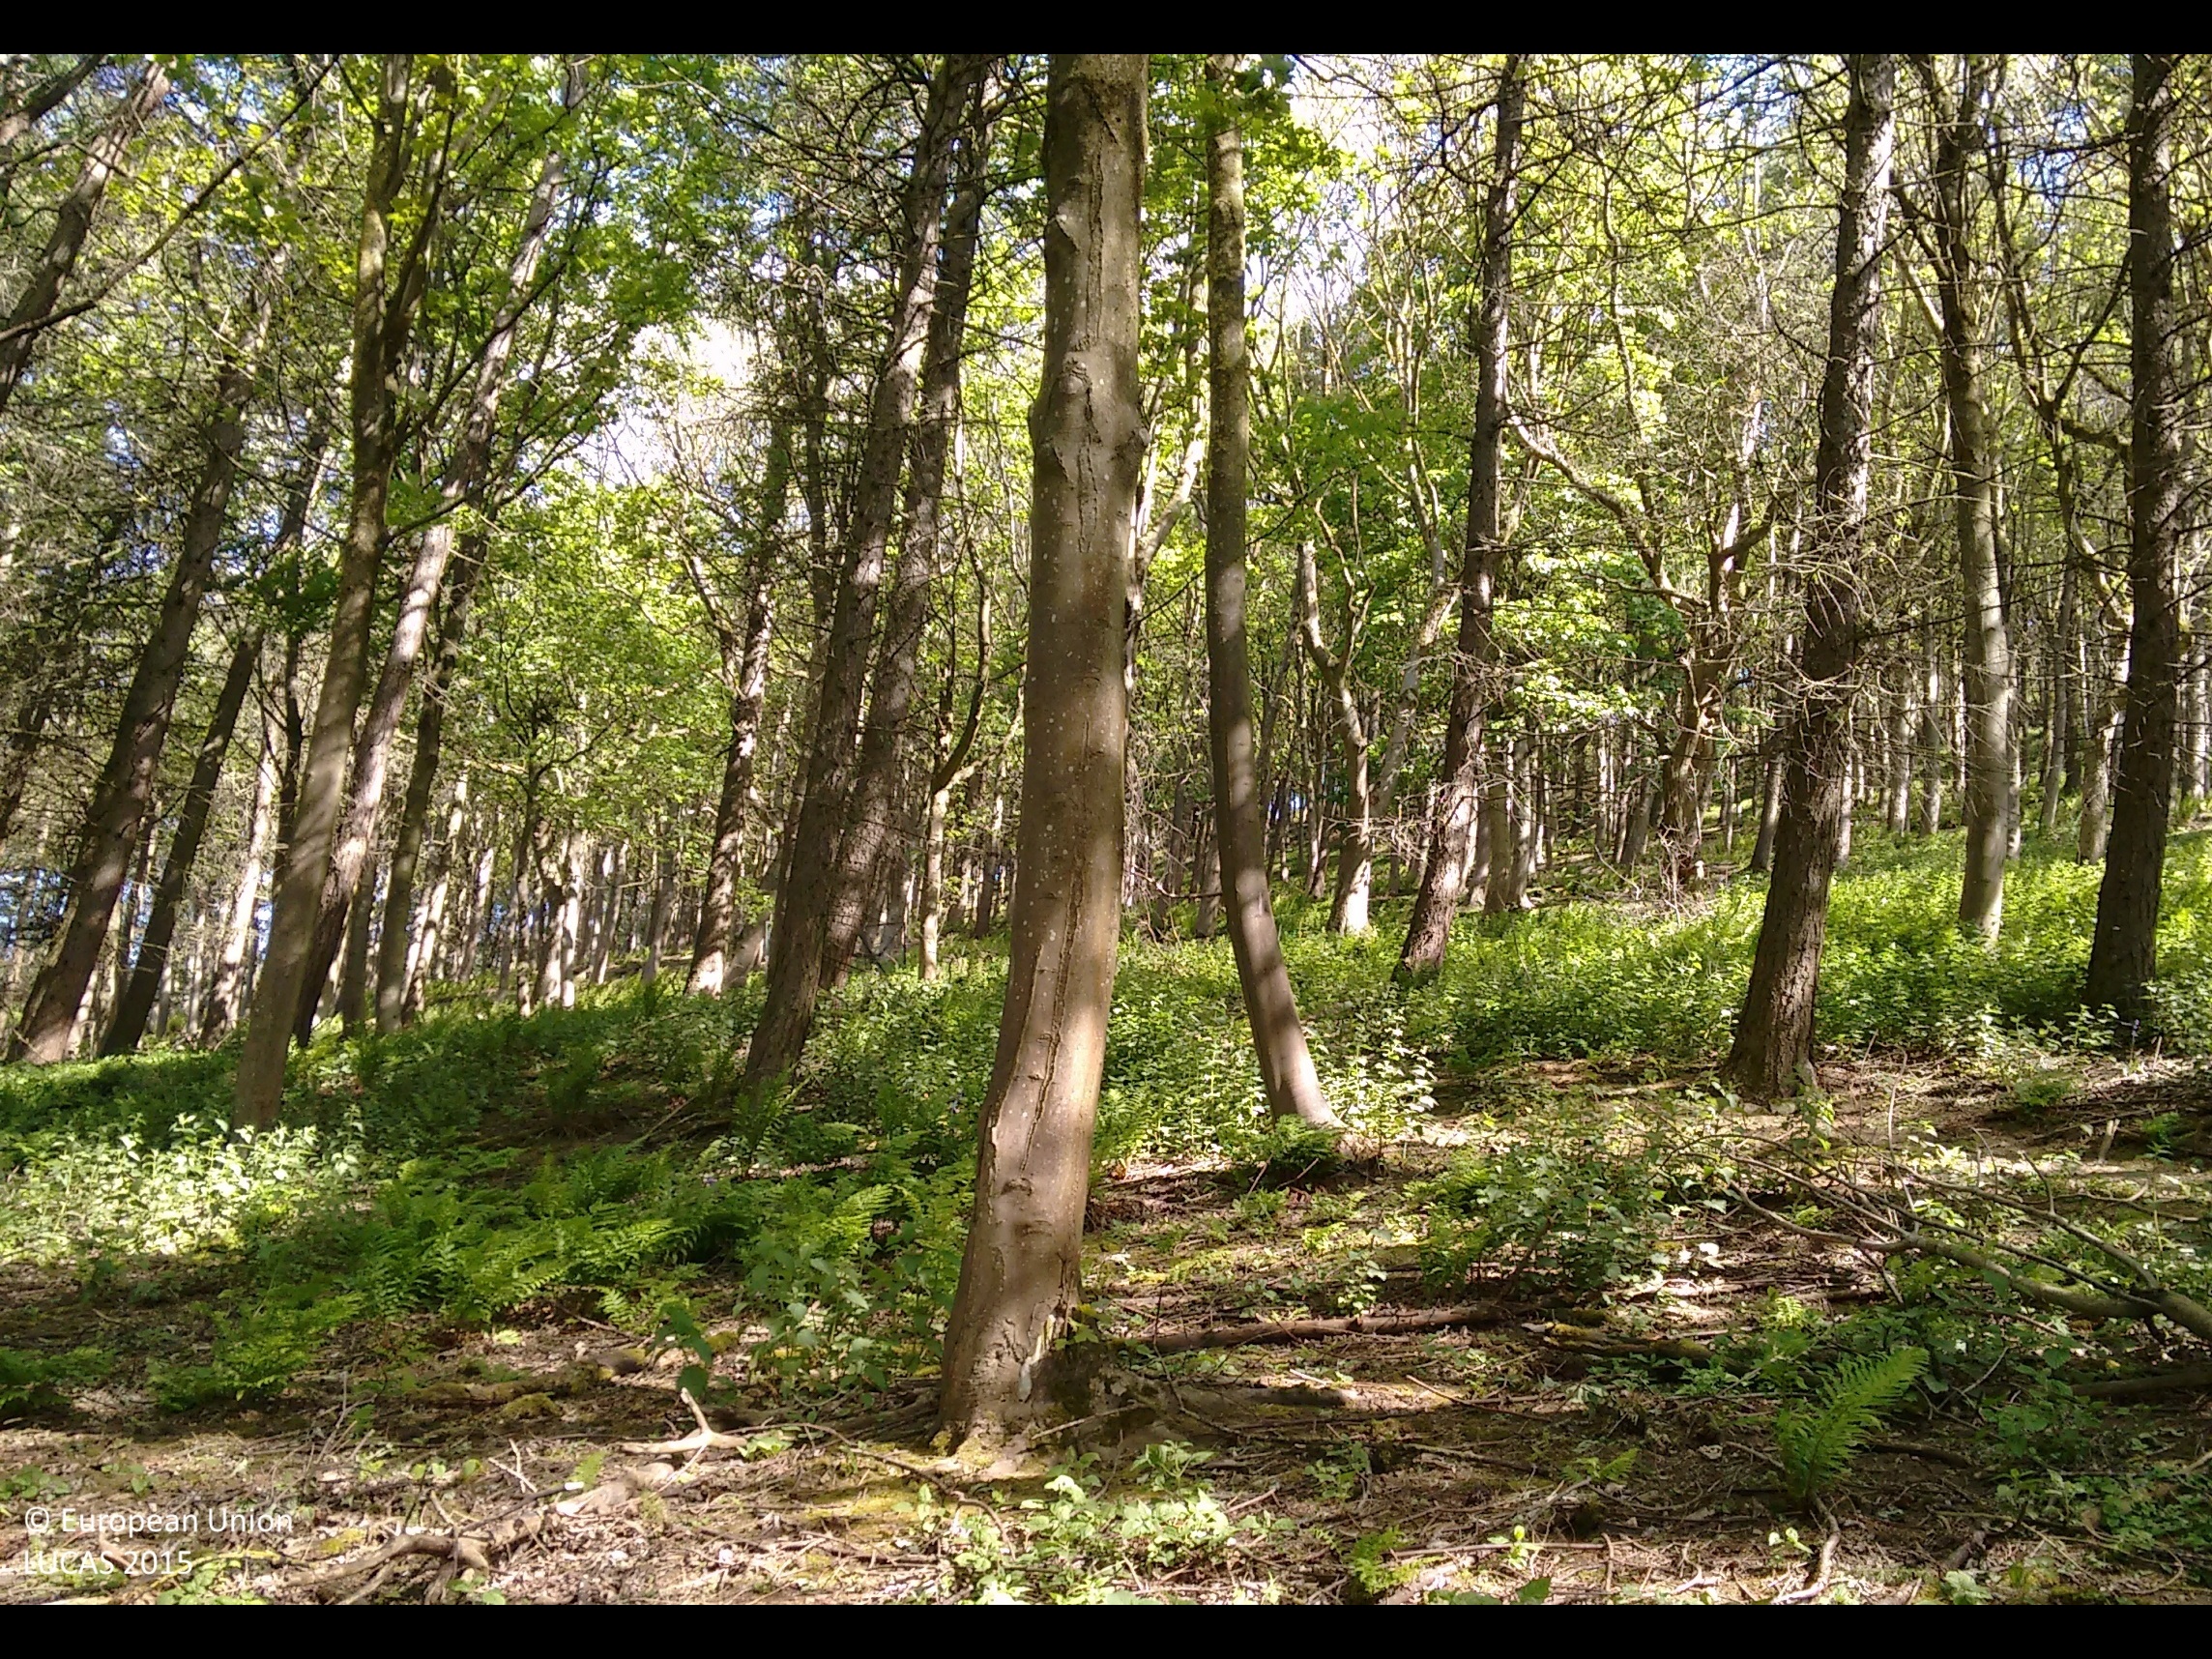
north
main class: Woodland
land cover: Broadleaved woodland
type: mesophytic deciduous forest
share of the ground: > 75 %
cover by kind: broadleaved forest trees 75 %, coniferous forest trees 25 %
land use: Forestry
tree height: > 5 m
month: June
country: GB
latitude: 54.3211
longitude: -1.9083
